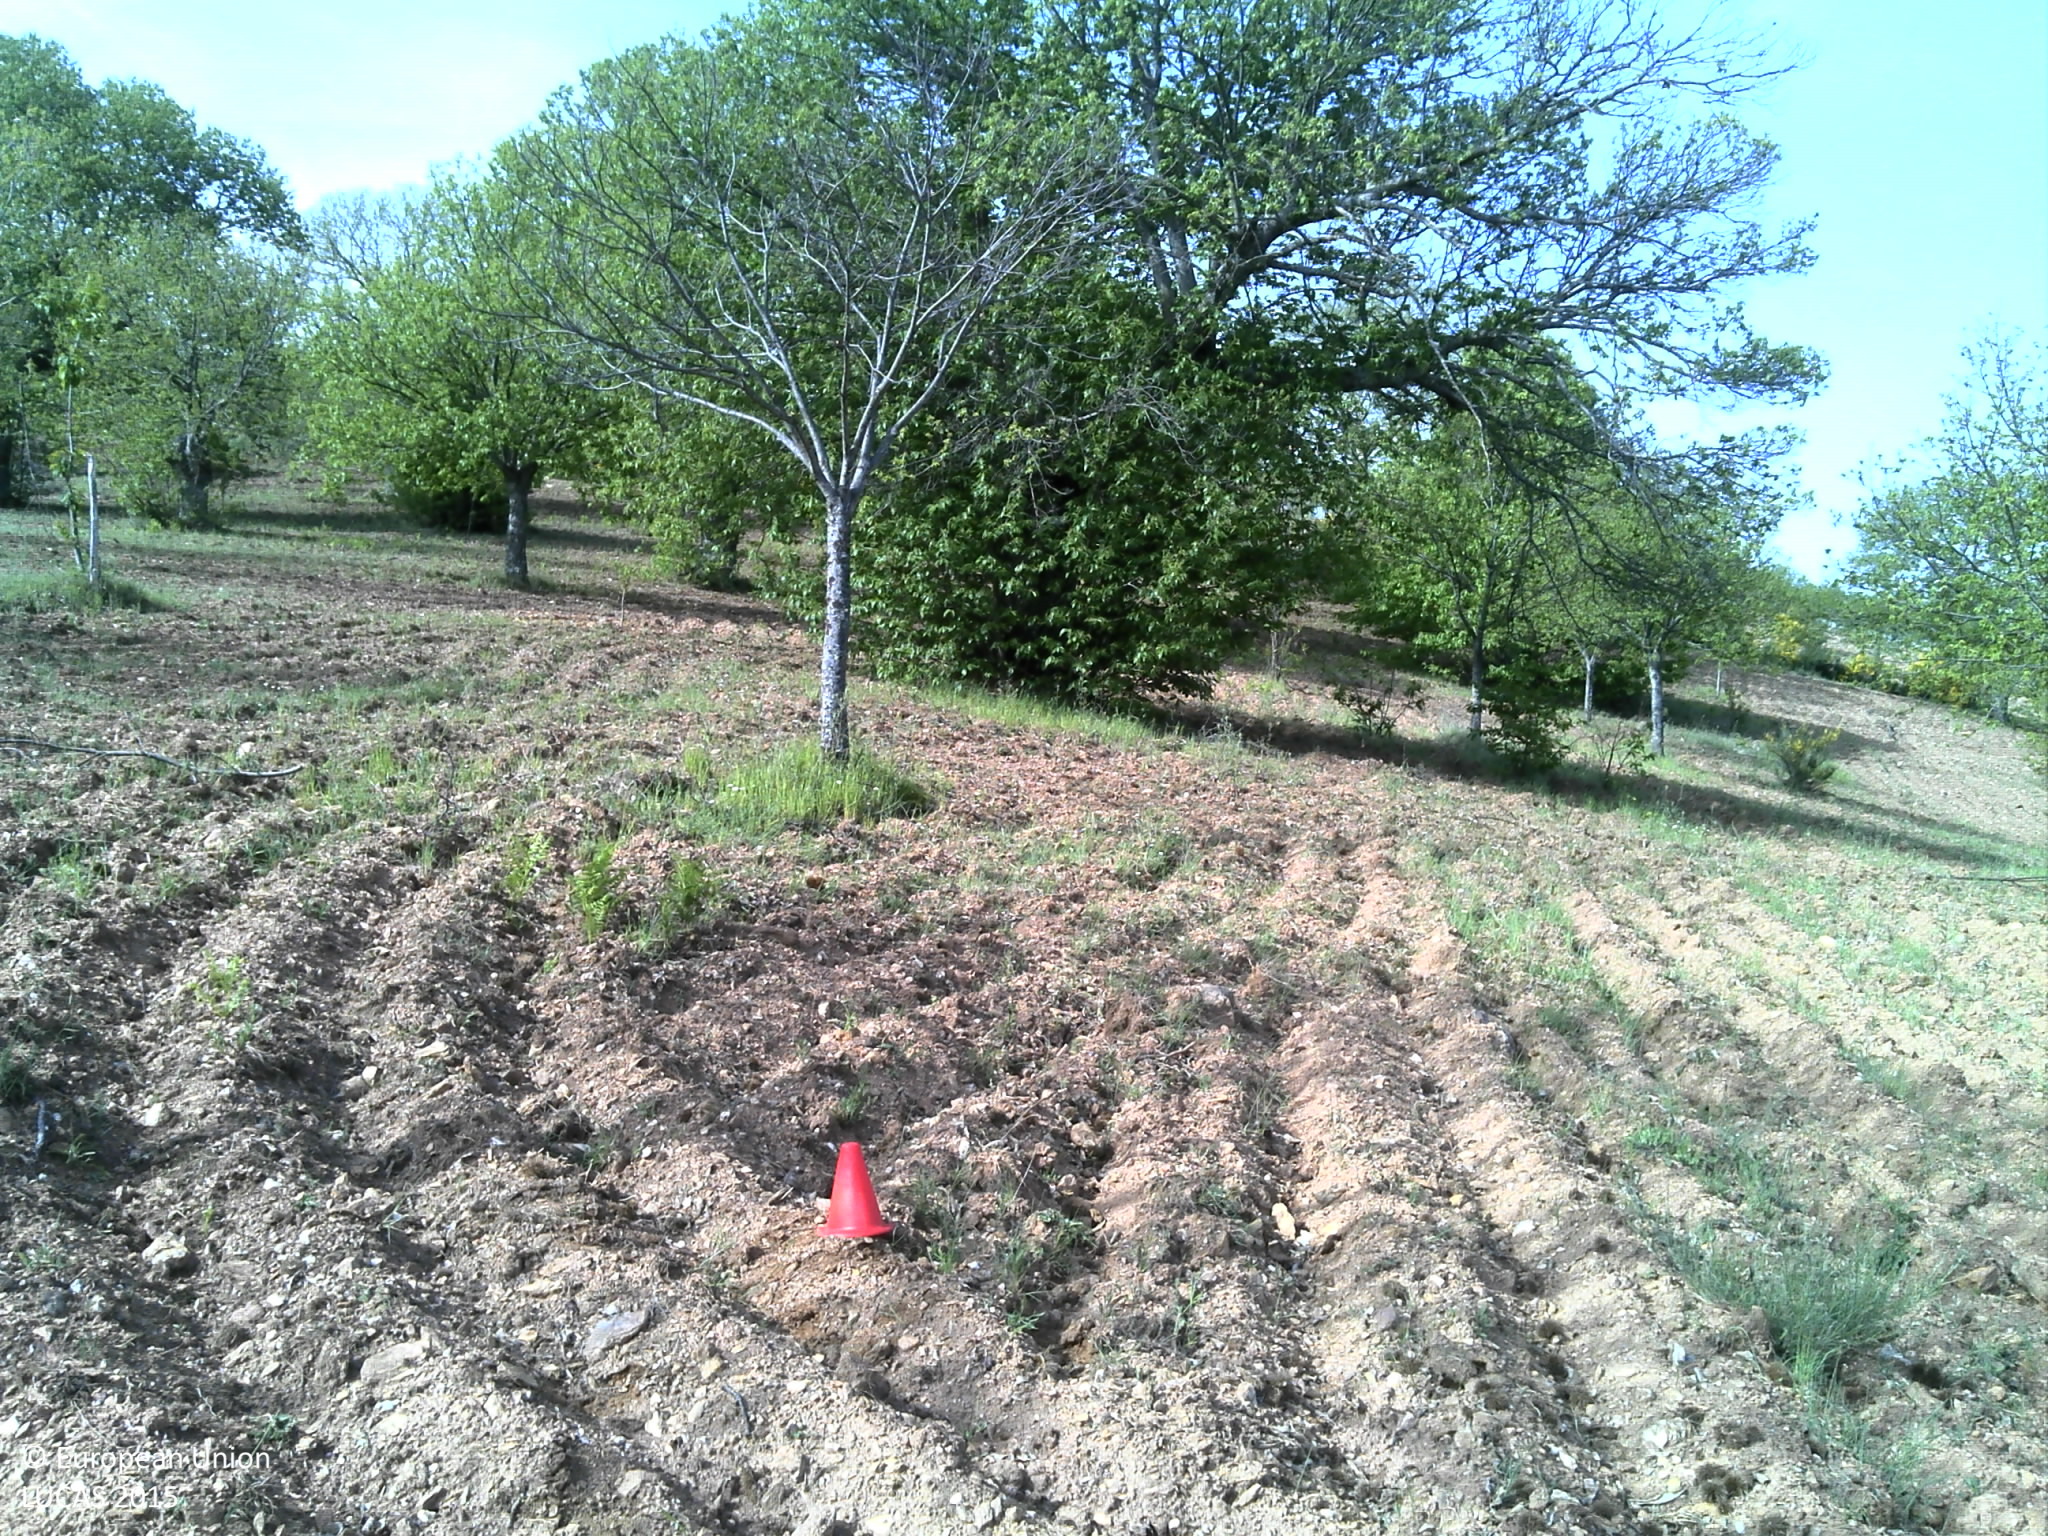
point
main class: Cropland
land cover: Nuts trees
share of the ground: 10 - 25 %
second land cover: Spontaneously vegetated surfaces
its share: 10 - 25 %
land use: Agriculture (excluding fallow land and kitchen gardens)
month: May
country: PT
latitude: 41.7096
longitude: -6.9542
